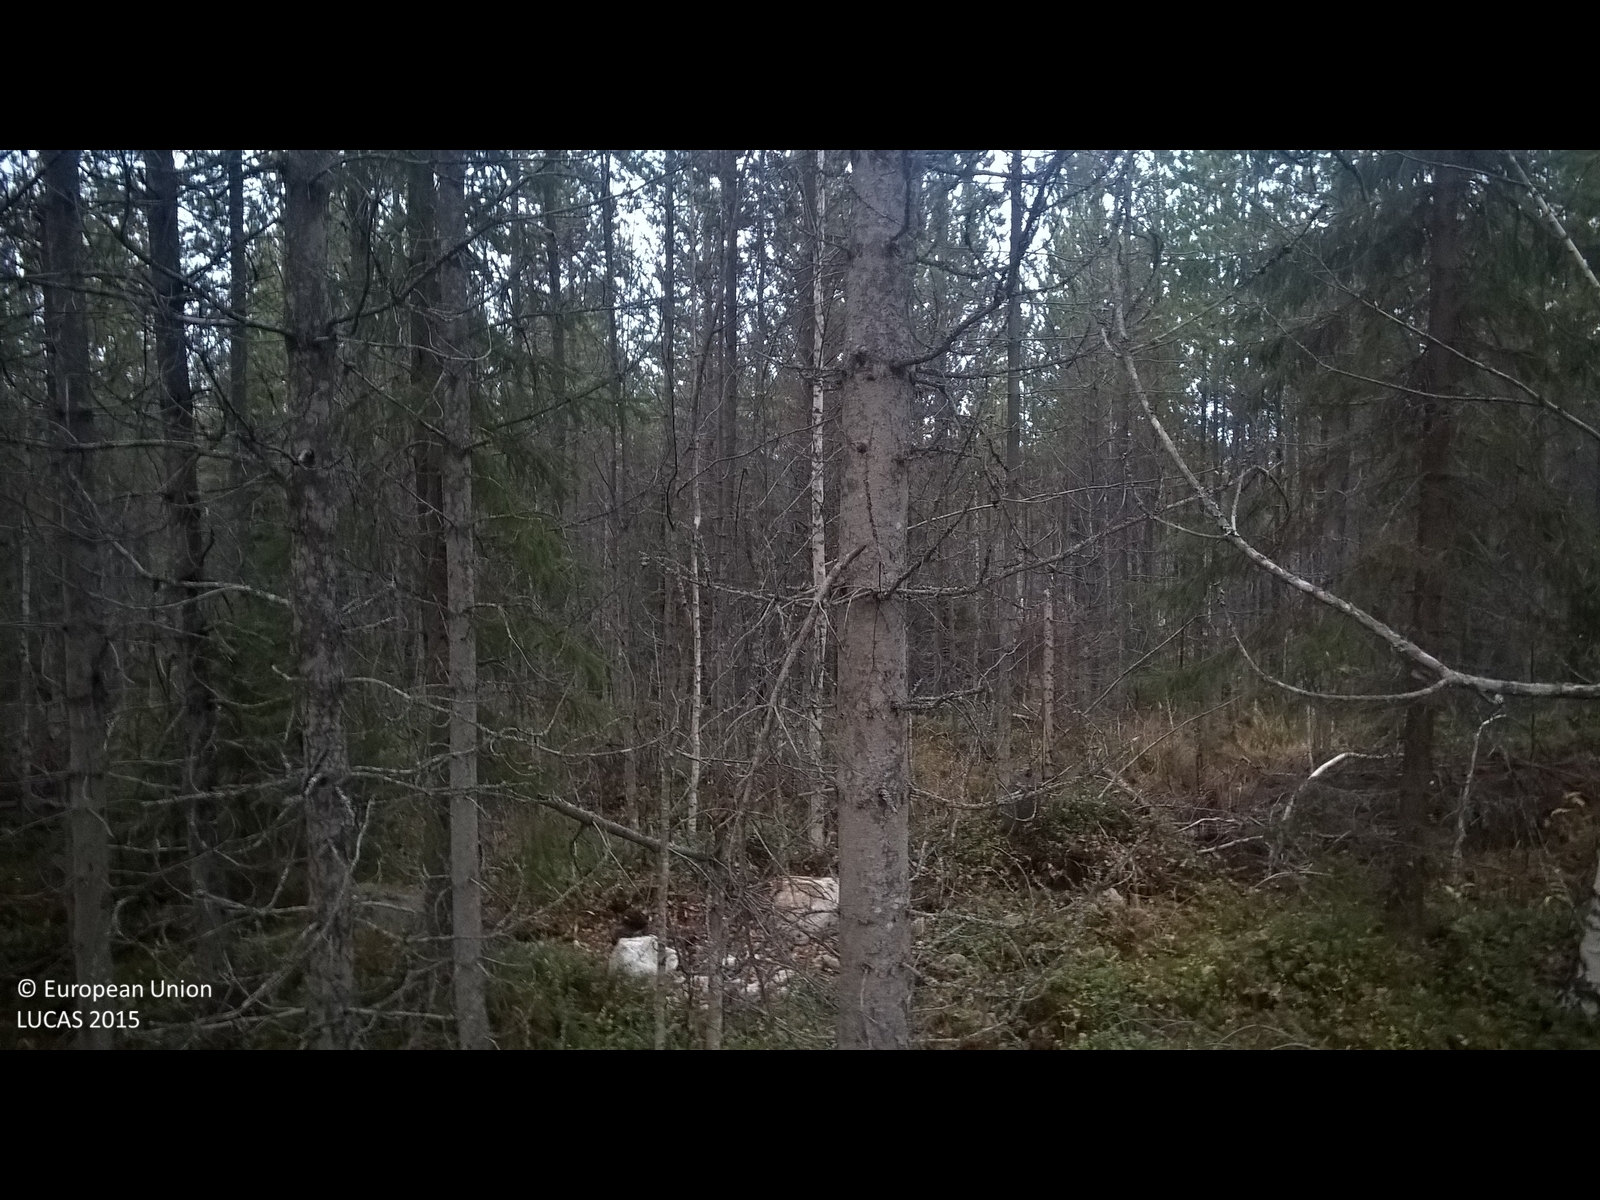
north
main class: Woodland
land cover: Pine dominated coniferous woodland
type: exotic forest
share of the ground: > 75 %
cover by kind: coniferous forest trees 75 %, lichens and mosses 25 %
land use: Forestry
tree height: > 5 m
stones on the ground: < 10 %
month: October
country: SE
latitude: 63.0614
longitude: 15.2998
